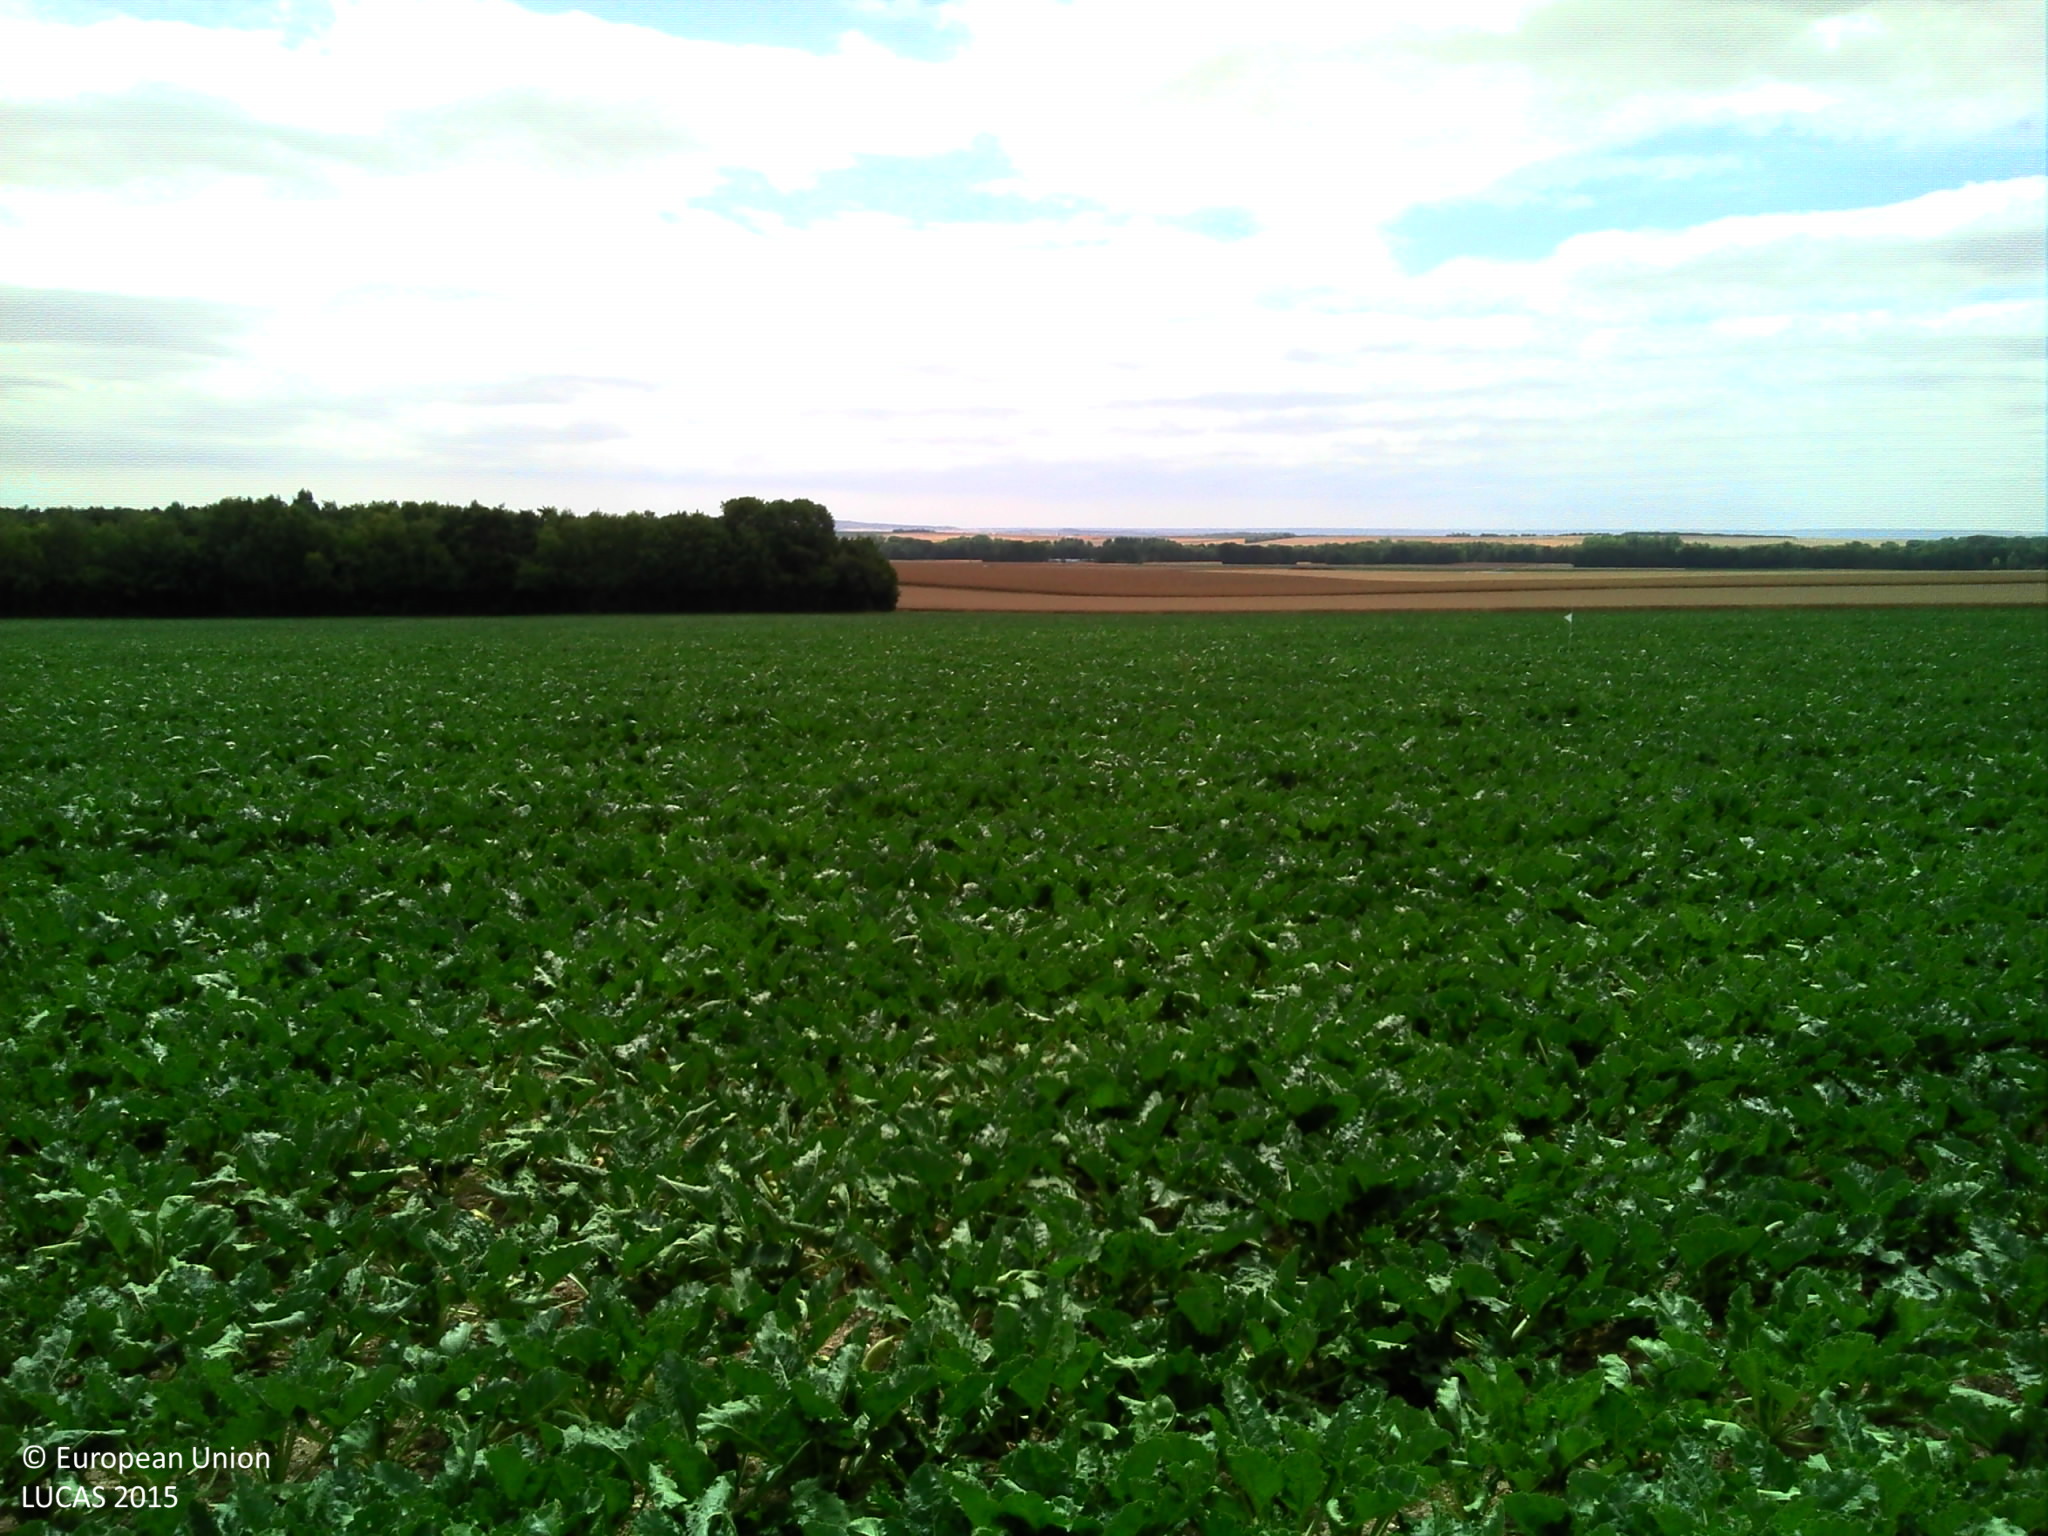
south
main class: Cropland
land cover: Sugar beet
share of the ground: > 75 %
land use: Agriculture (excluding fallow land and kitchen gardens)
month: July
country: FR
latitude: 49.4024
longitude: 4.1385
